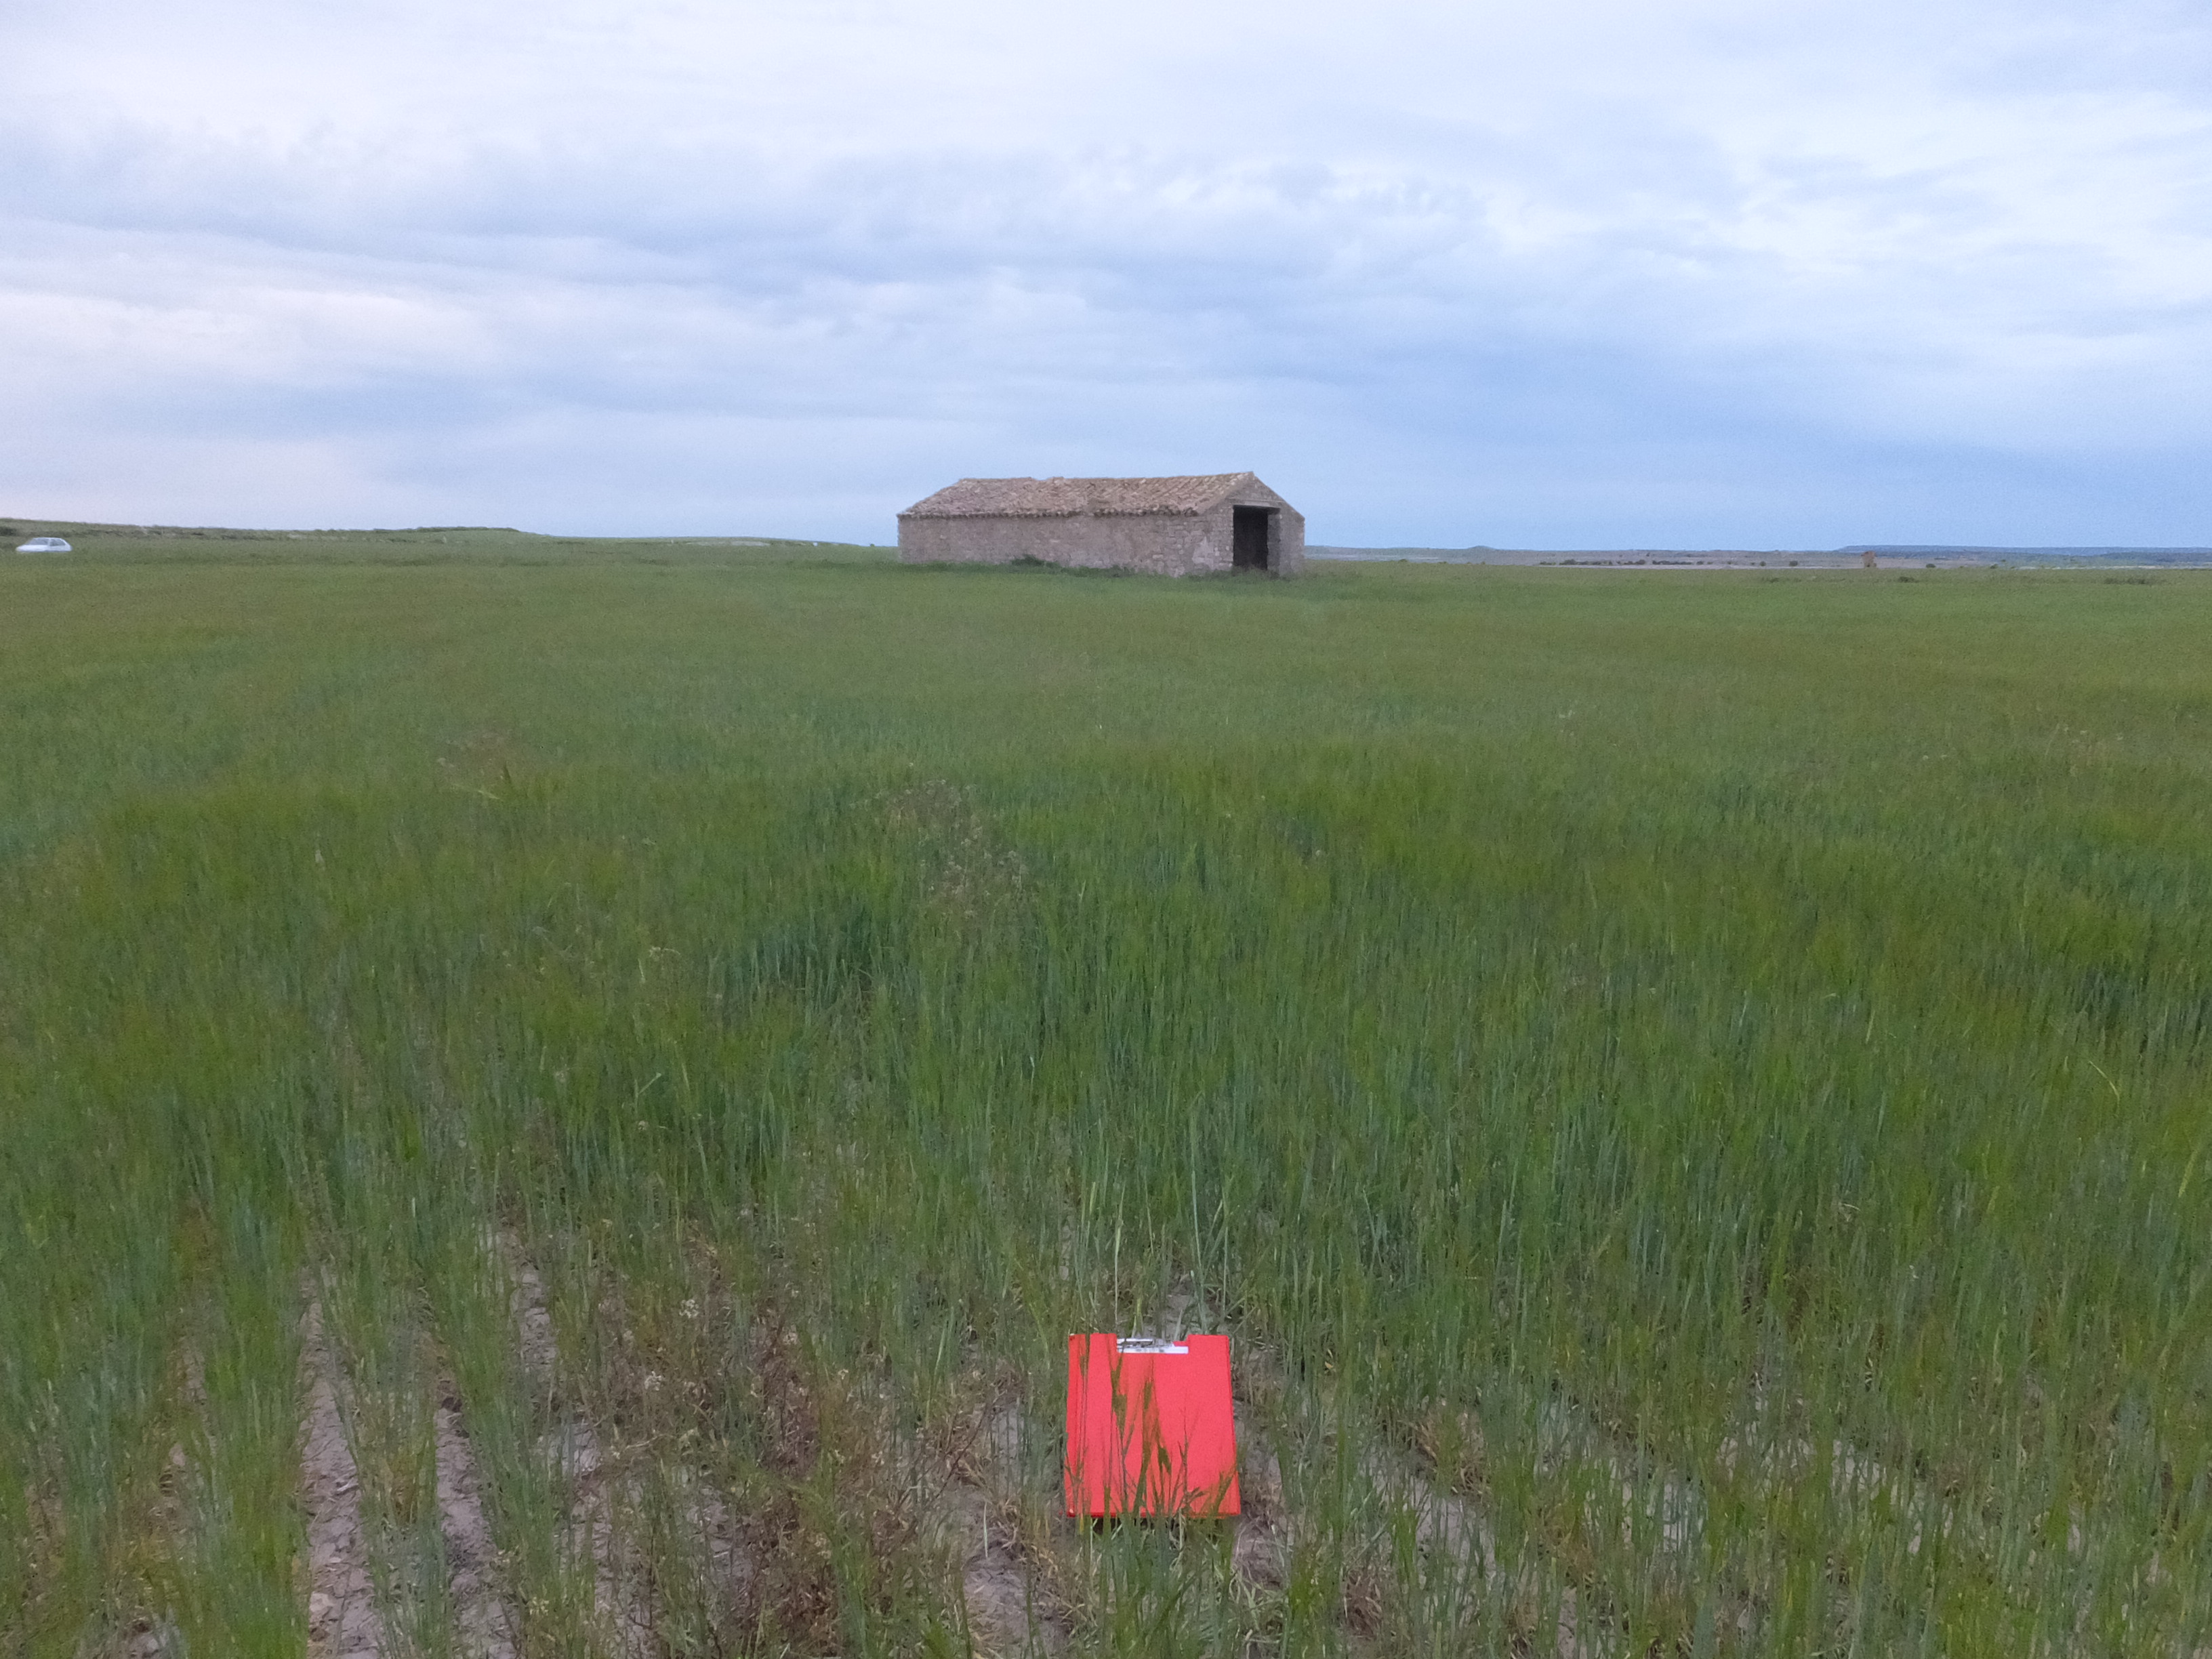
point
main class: Cropland
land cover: Barley
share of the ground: > 75 %
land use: Agriculture (excluding fallow land and kitchen gardens)
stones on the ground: < 10 %
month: April
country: ES
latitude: 41.6324
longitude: -0.1600
